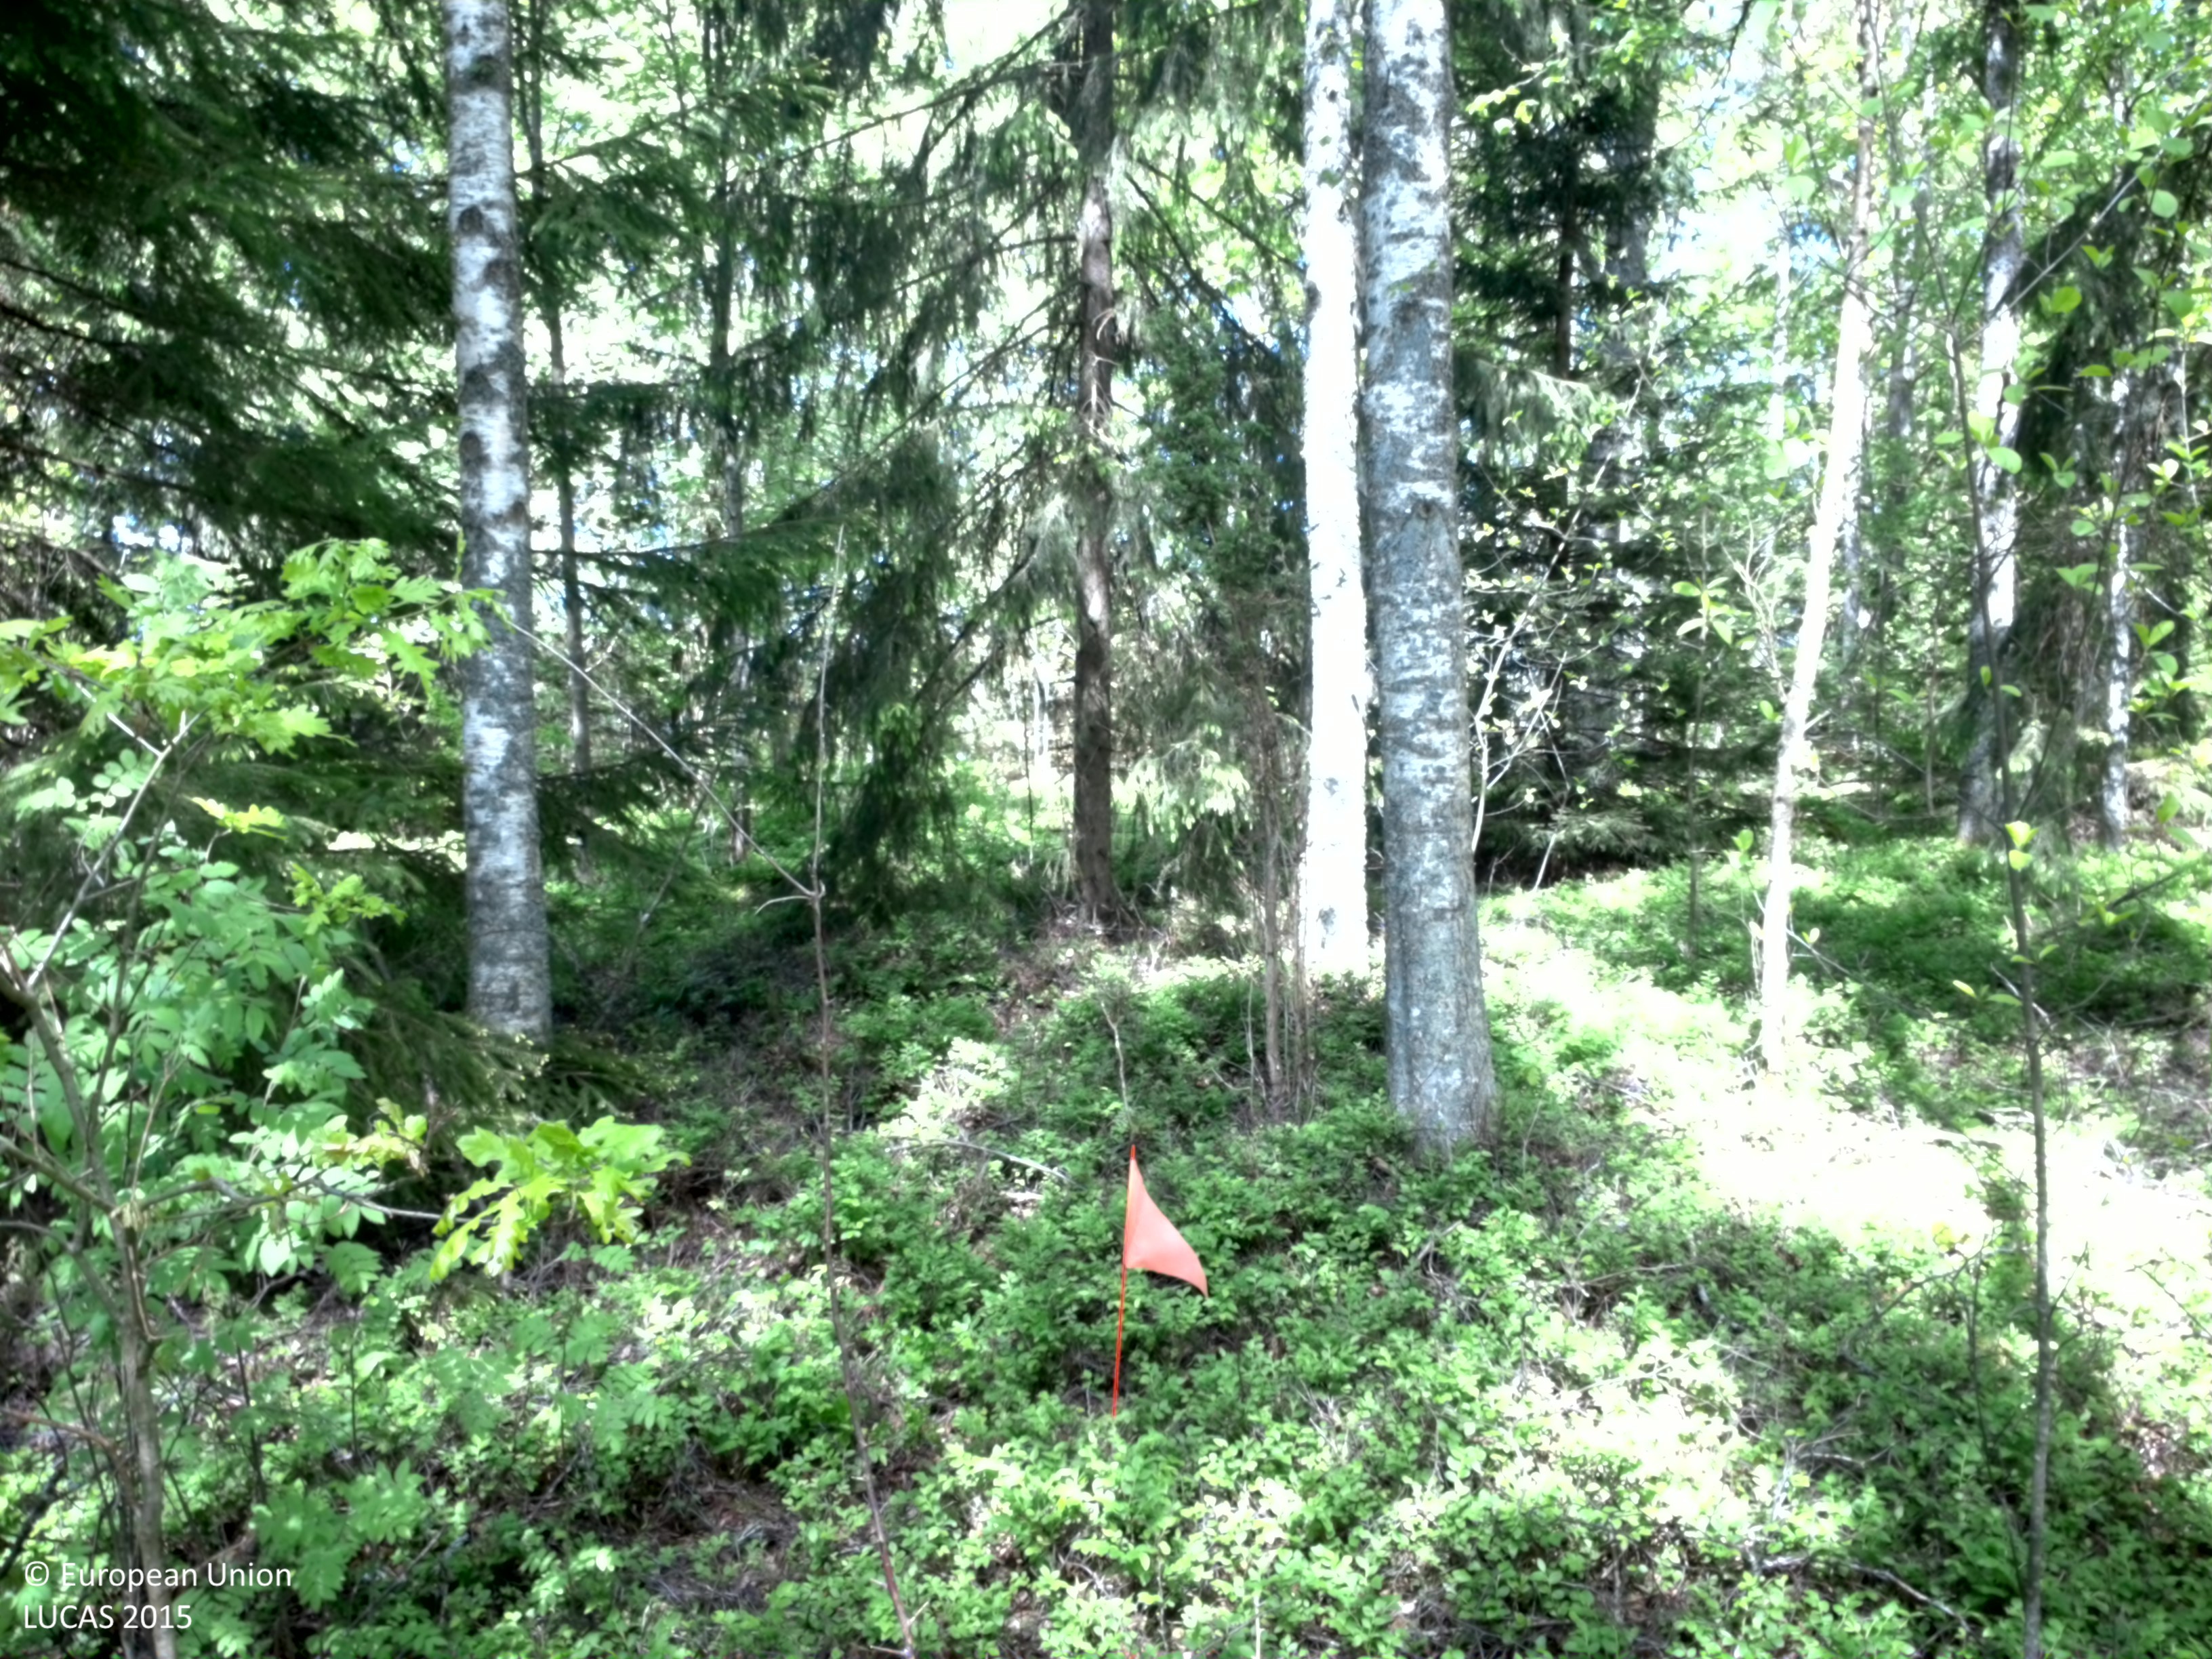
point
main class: Woodland
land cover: Spruce dominated mixed woodland
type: boreal forest
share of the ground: 50 - 75 %
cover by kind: broadleaved forest trees 40 %, coniferous forest trees 25 %, shrubs 20 %, lichens and mosses 10 %, herbaceous plants 5 %
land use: Forestry
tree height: > 5 m
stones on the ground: < 10 %
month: June
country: SE
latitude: 56.6596
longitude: 14.7122
